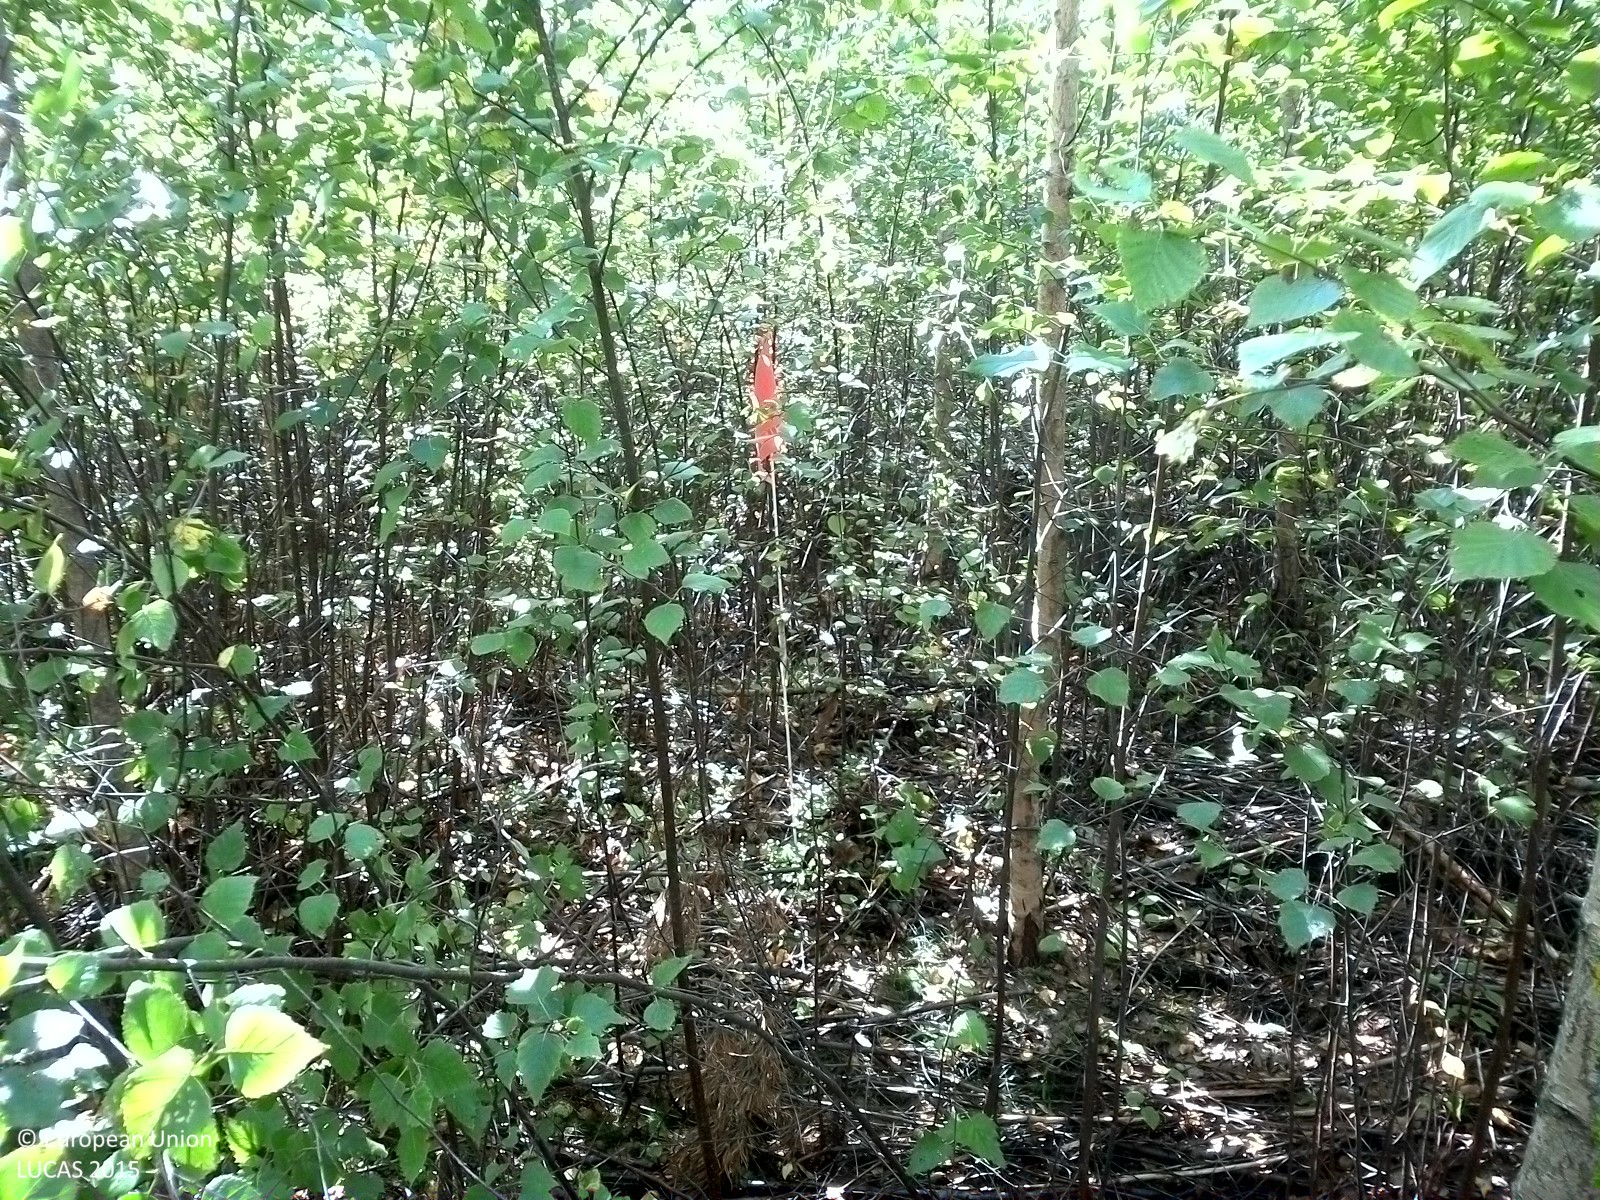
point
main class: Woodland
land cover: Broadleaved woodland
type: hemiboreal forest and nemoral coniferous forest and mixed broadleaved-coniferous forest
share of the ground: > 75 %
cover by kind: broadleaved forest trees 90 %, herbaceous plants 5 %, unconsolidated bare surface 5 %
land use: Forestry
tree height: < 5 m
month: August
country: SE
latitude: 59.2469
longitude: 15.4096
